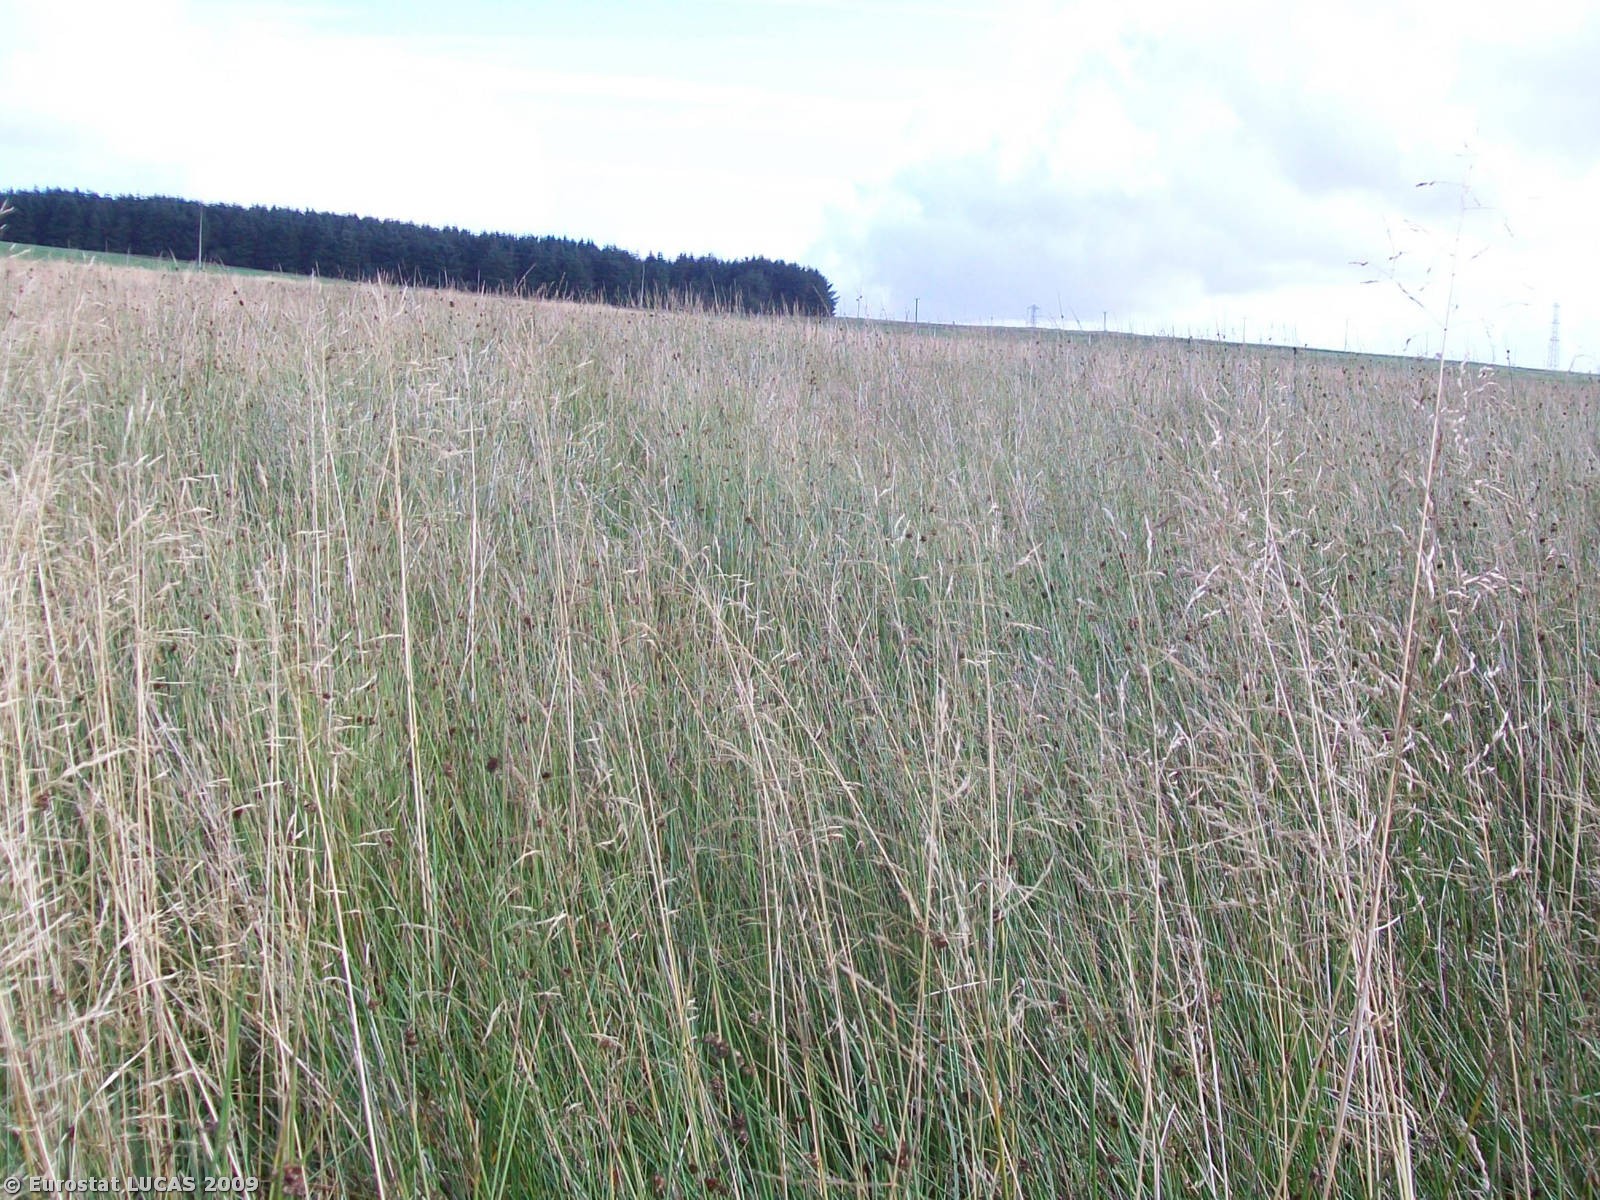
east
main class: Grassland
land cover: Grassland without tree/shrub cover
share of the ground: 10 - 25 %
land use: Agriculture (excluding fallow land and kitchen gardens)
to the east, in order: Grassland without tree/shrub cover
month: September
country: GB
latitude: 55.6674
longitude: -4.1945
